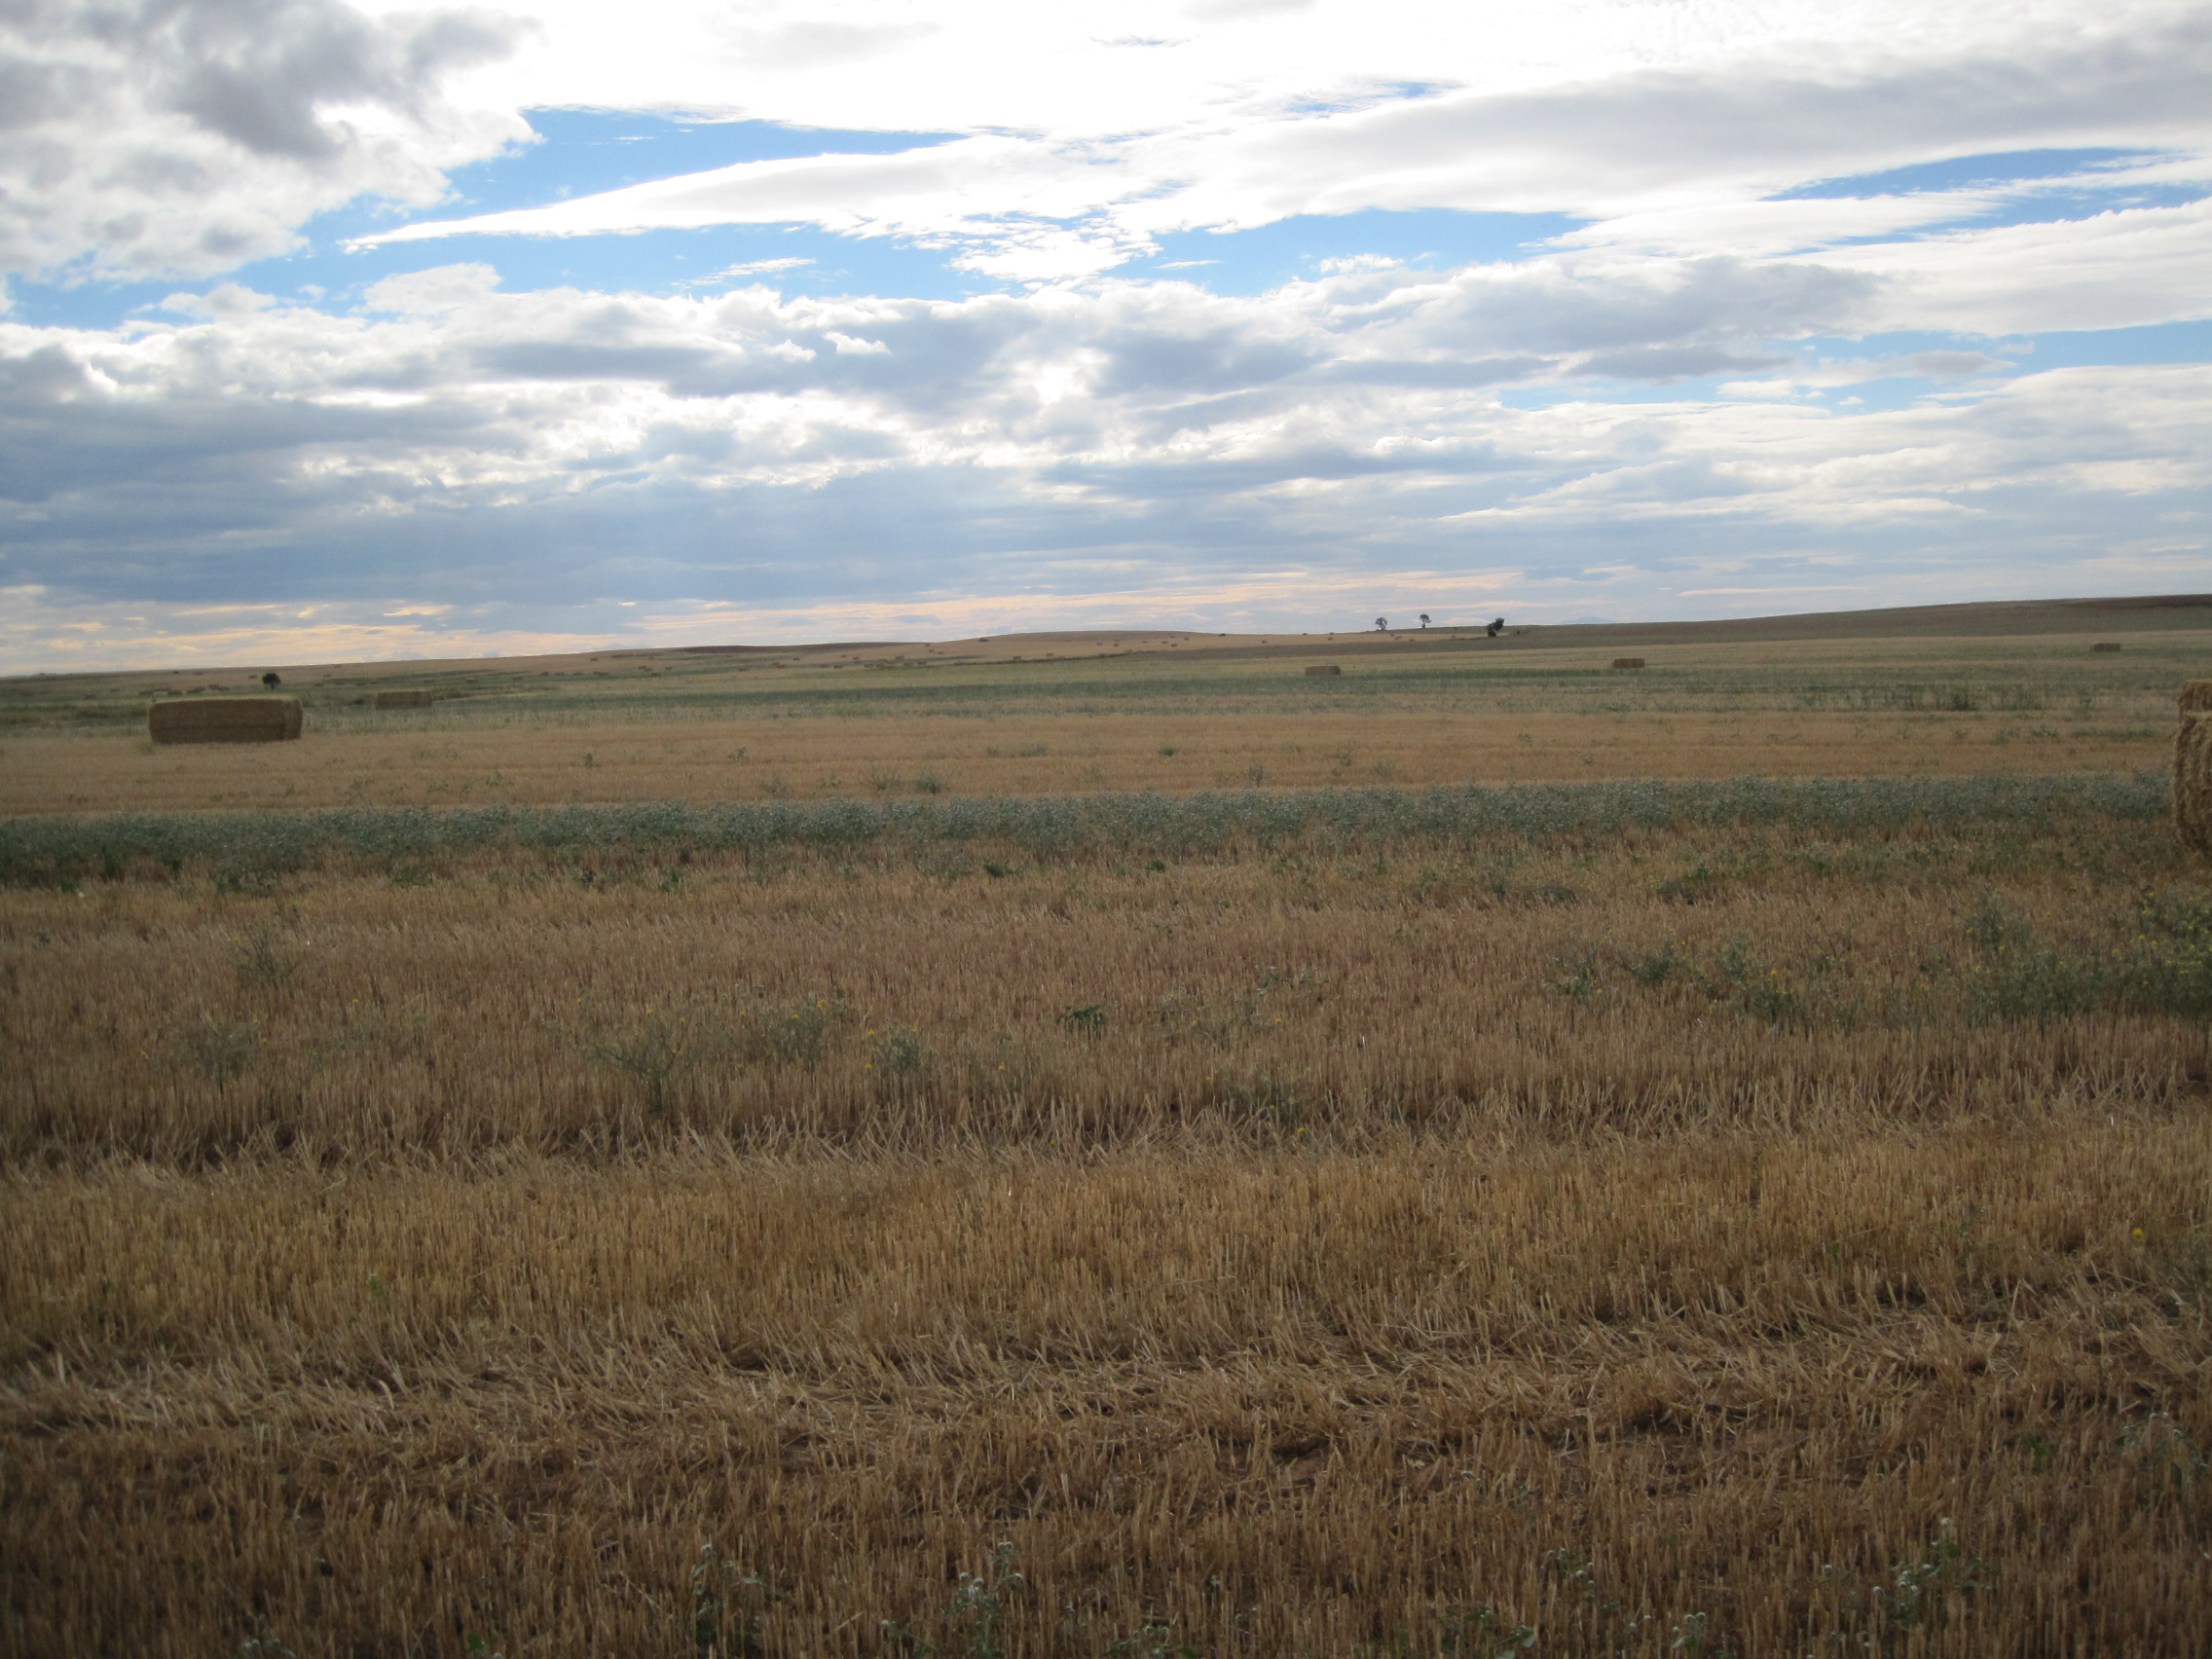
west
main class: Cropland
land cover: Barley
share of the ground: < 10 %
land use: Agriculture (excluding fallow land and kitchen gardens)
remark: Harvested field
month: July
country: ES
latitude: 41.9669
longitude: -5.4966
